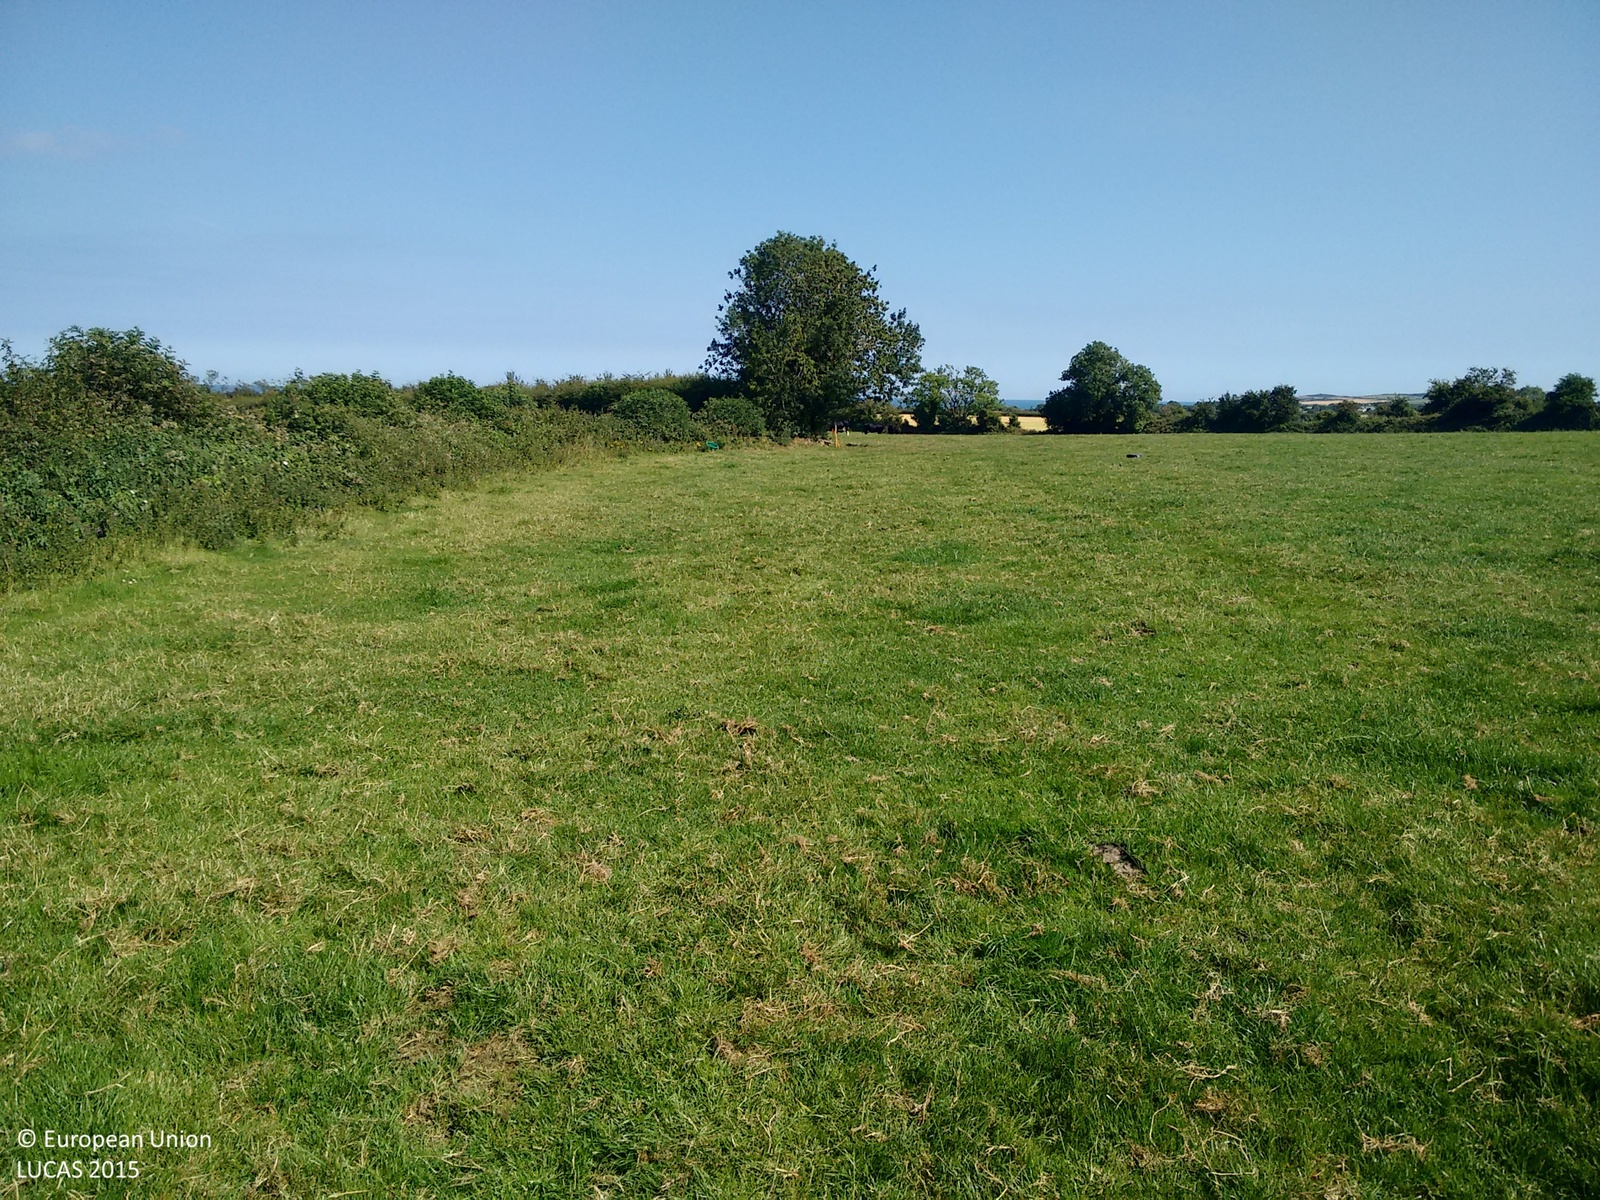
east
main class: Grassland
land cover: Grassland without tree/shrub cover
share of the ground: > 75 %
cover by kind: herbaceous plants 100 %
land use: Agriculture (excluding fallow land and kitchen gardens)
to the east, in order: Grassland without tree/shrub cover; Managed hedges; Grassland without tree/shrub cover; Electric lines; Managed hedges; Ditches and canals; Managed hedges; Grass margins; Common wheat
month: August
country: IE
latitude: 53.8120
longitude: -6.2945
